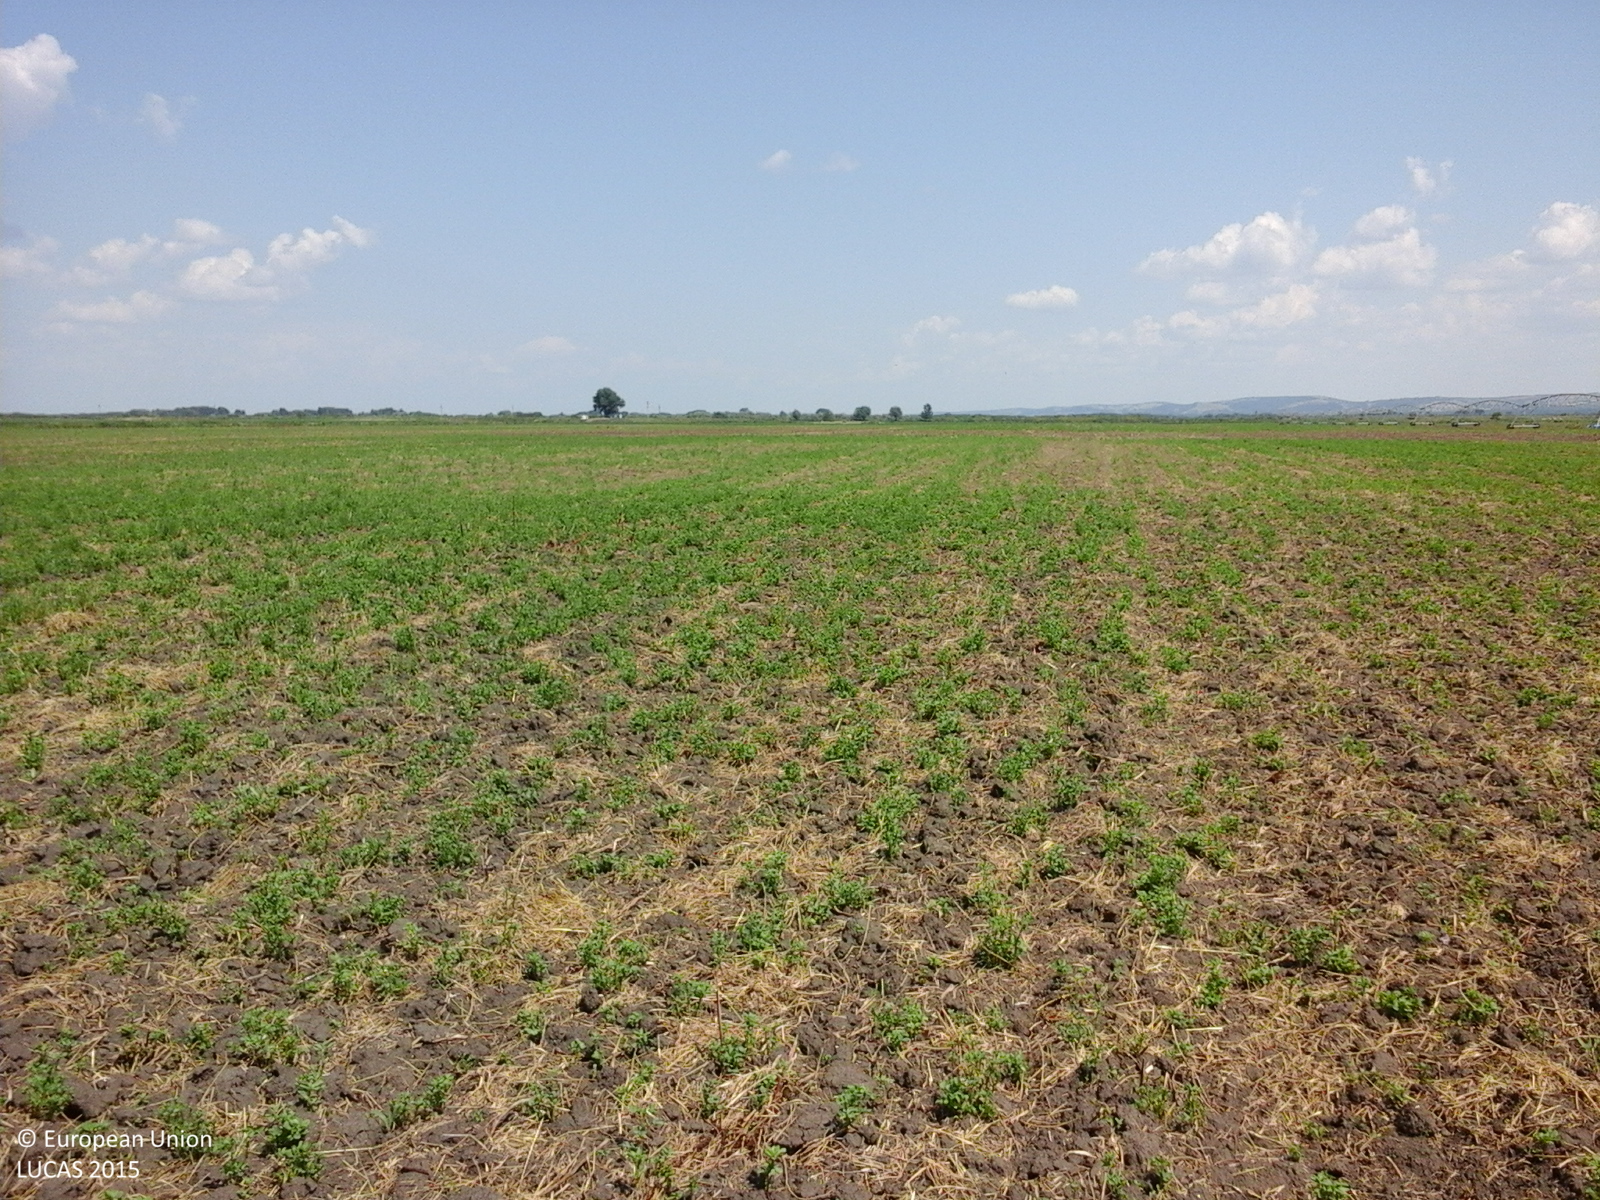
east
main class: Cropland
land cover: Clovers
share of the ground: 10 - 25 %
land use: Agriculture (excluding fallow land and kitchen gardens)
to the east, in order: Clovers
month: July
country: RO
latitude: 43.7266
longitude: 24.1221
